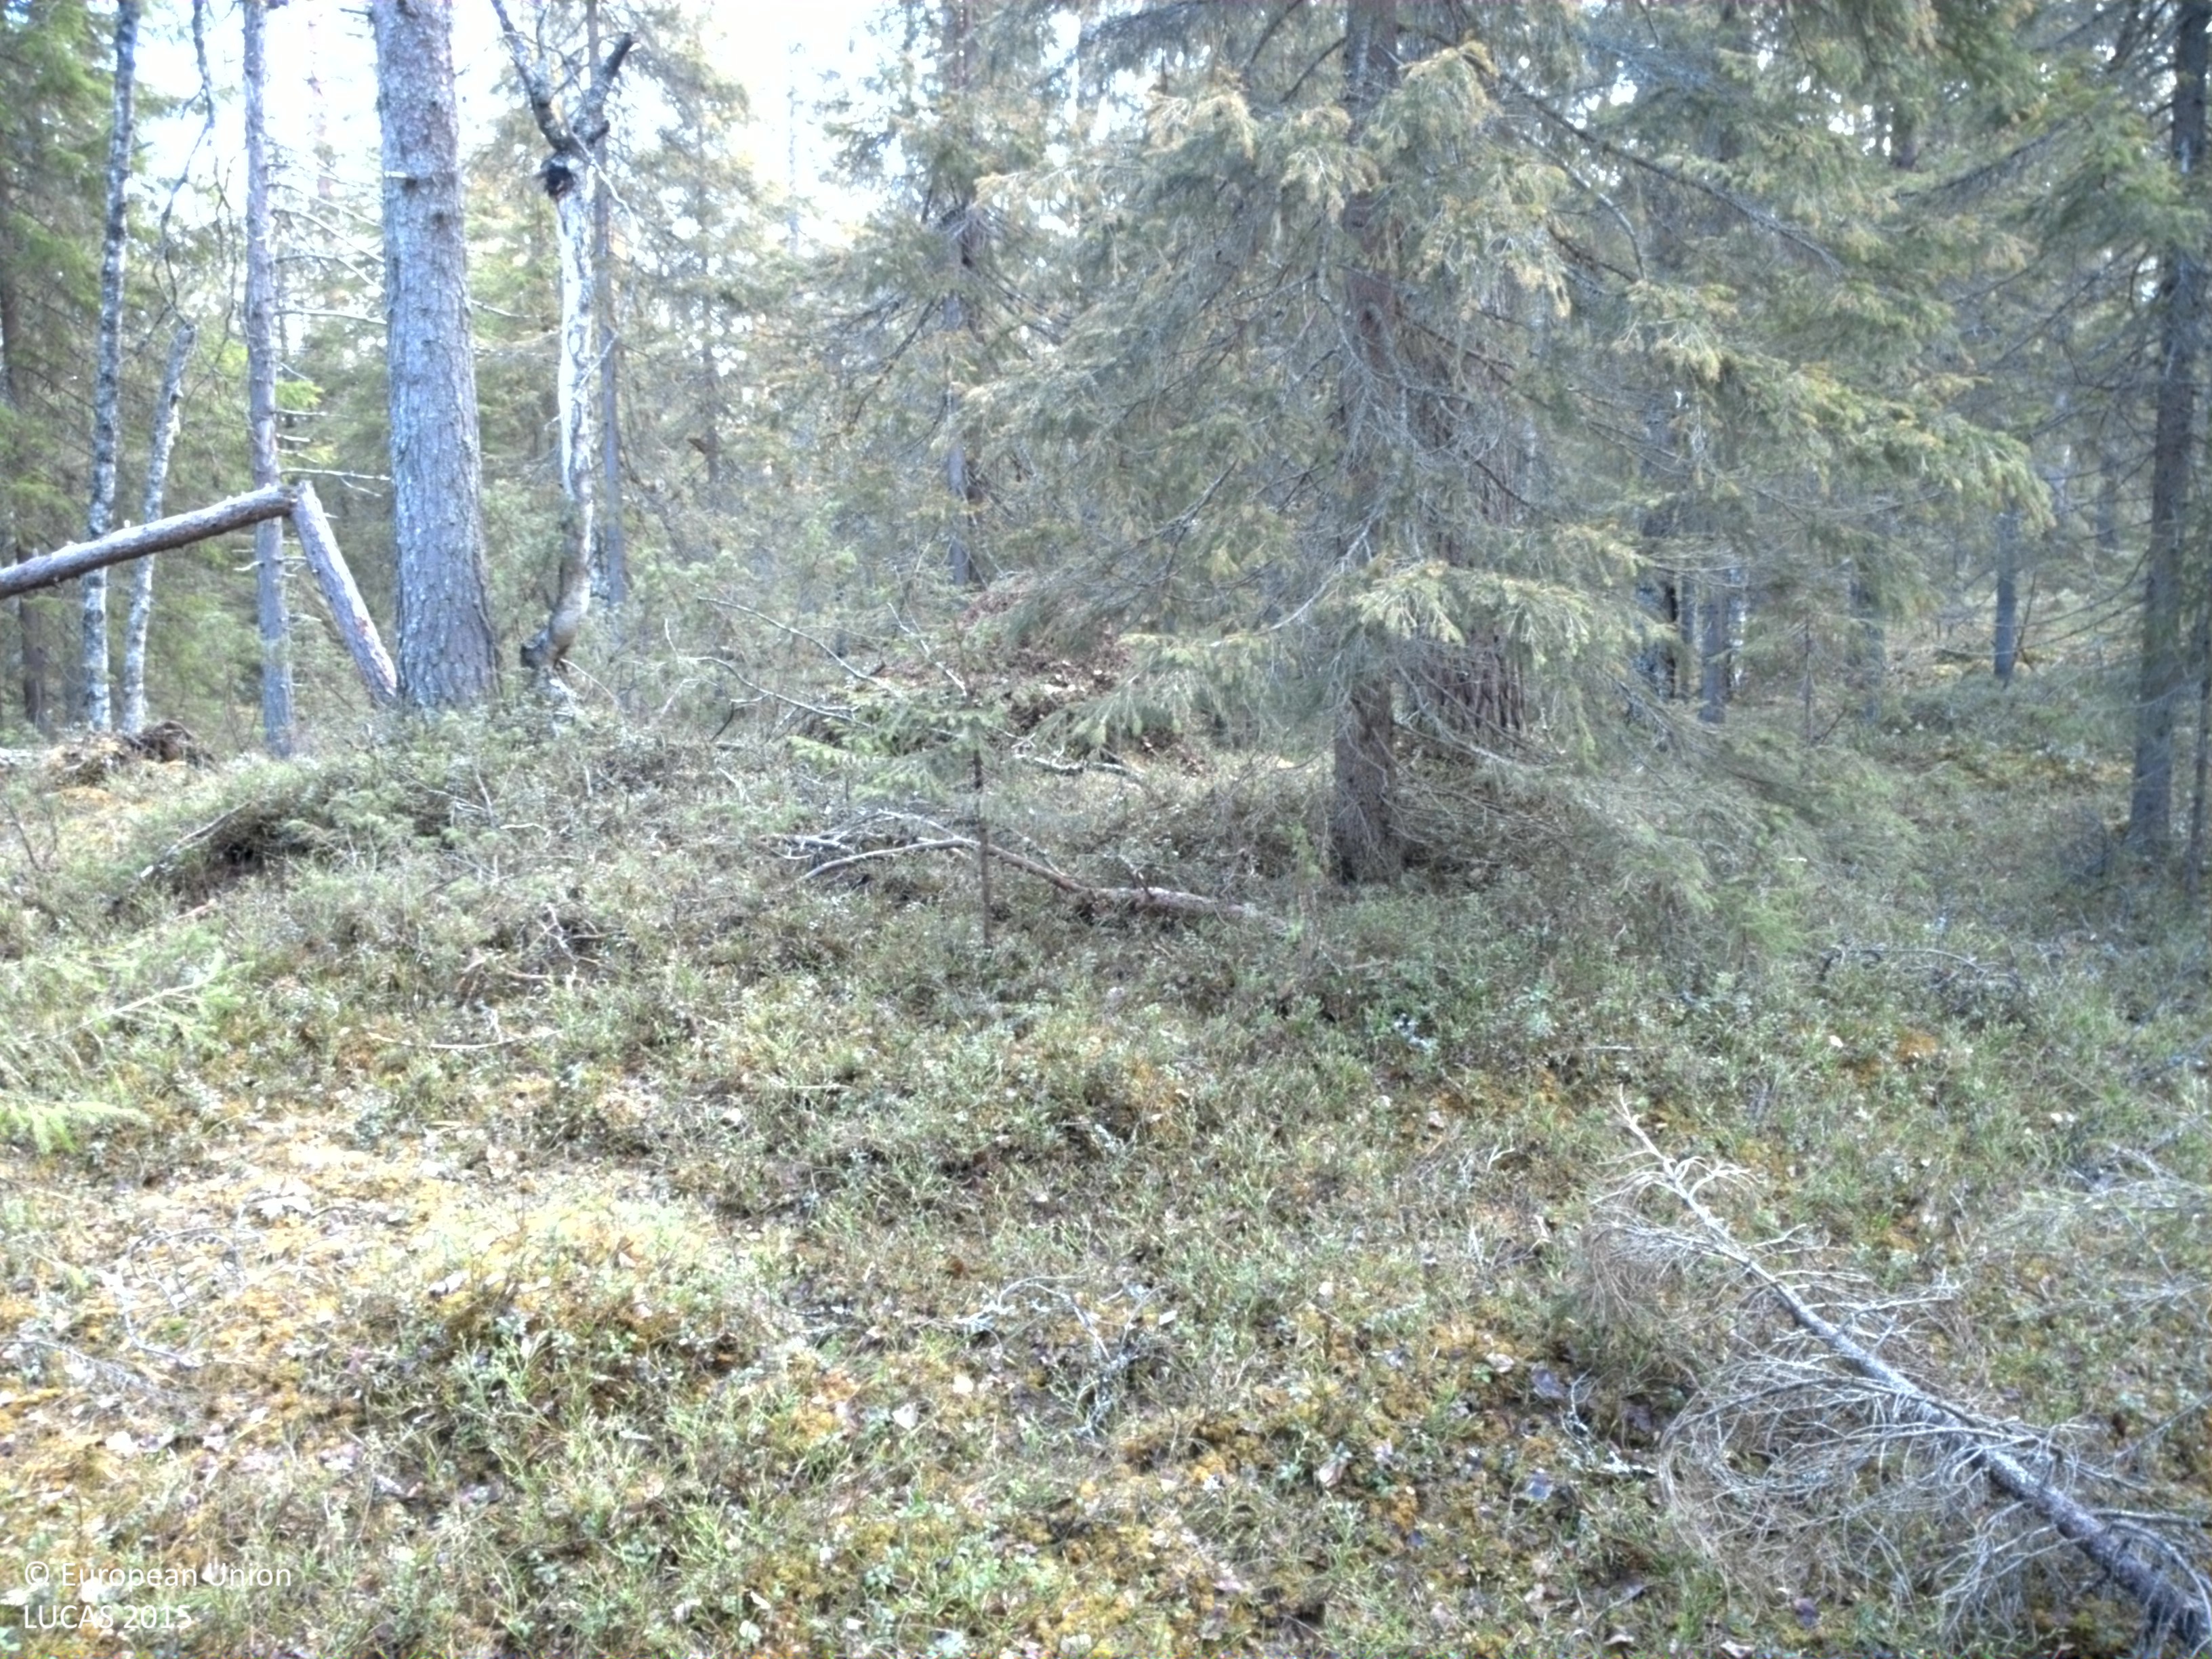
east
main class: Woodland
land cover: Spruce dominated coniferous woodland
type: boreal forest
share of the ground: > 75 %
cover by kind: coniferous forest trees 75 %, shrubs 15 %, broadleaved forest trees 10 %
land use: Forestry
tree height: > 5 m
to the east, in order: Spruce dominated coniferous woodland
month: June
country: SE
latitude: 66.4309
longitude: 23.2721
